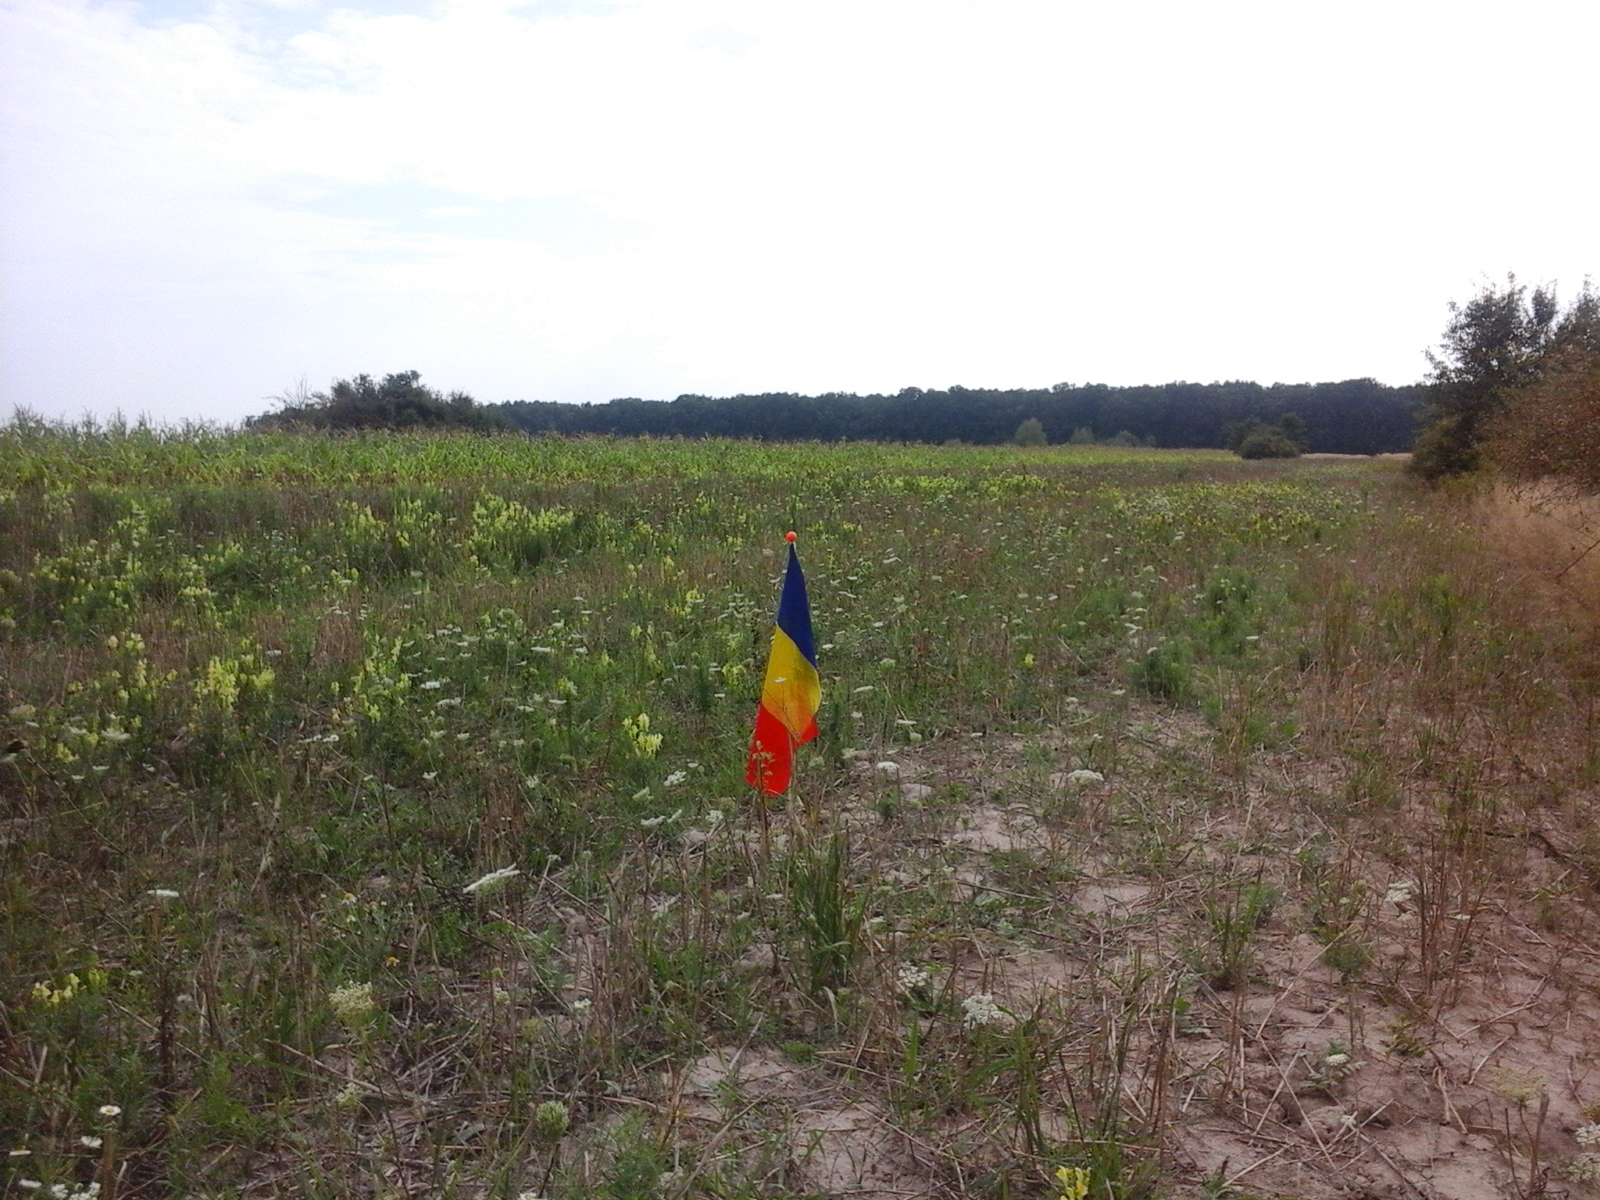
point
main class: Grassland
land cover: Spontaneously vegetated surfaces
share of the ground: > 75 %
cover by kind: herbaceous plants 95 %, unconsolidated bare surface 5 %
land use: Agriculture (excluding fallow land and kitchen gardens)
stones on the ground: < 10 %
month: August
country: RO
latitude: 46.5903
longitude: 21.9341
